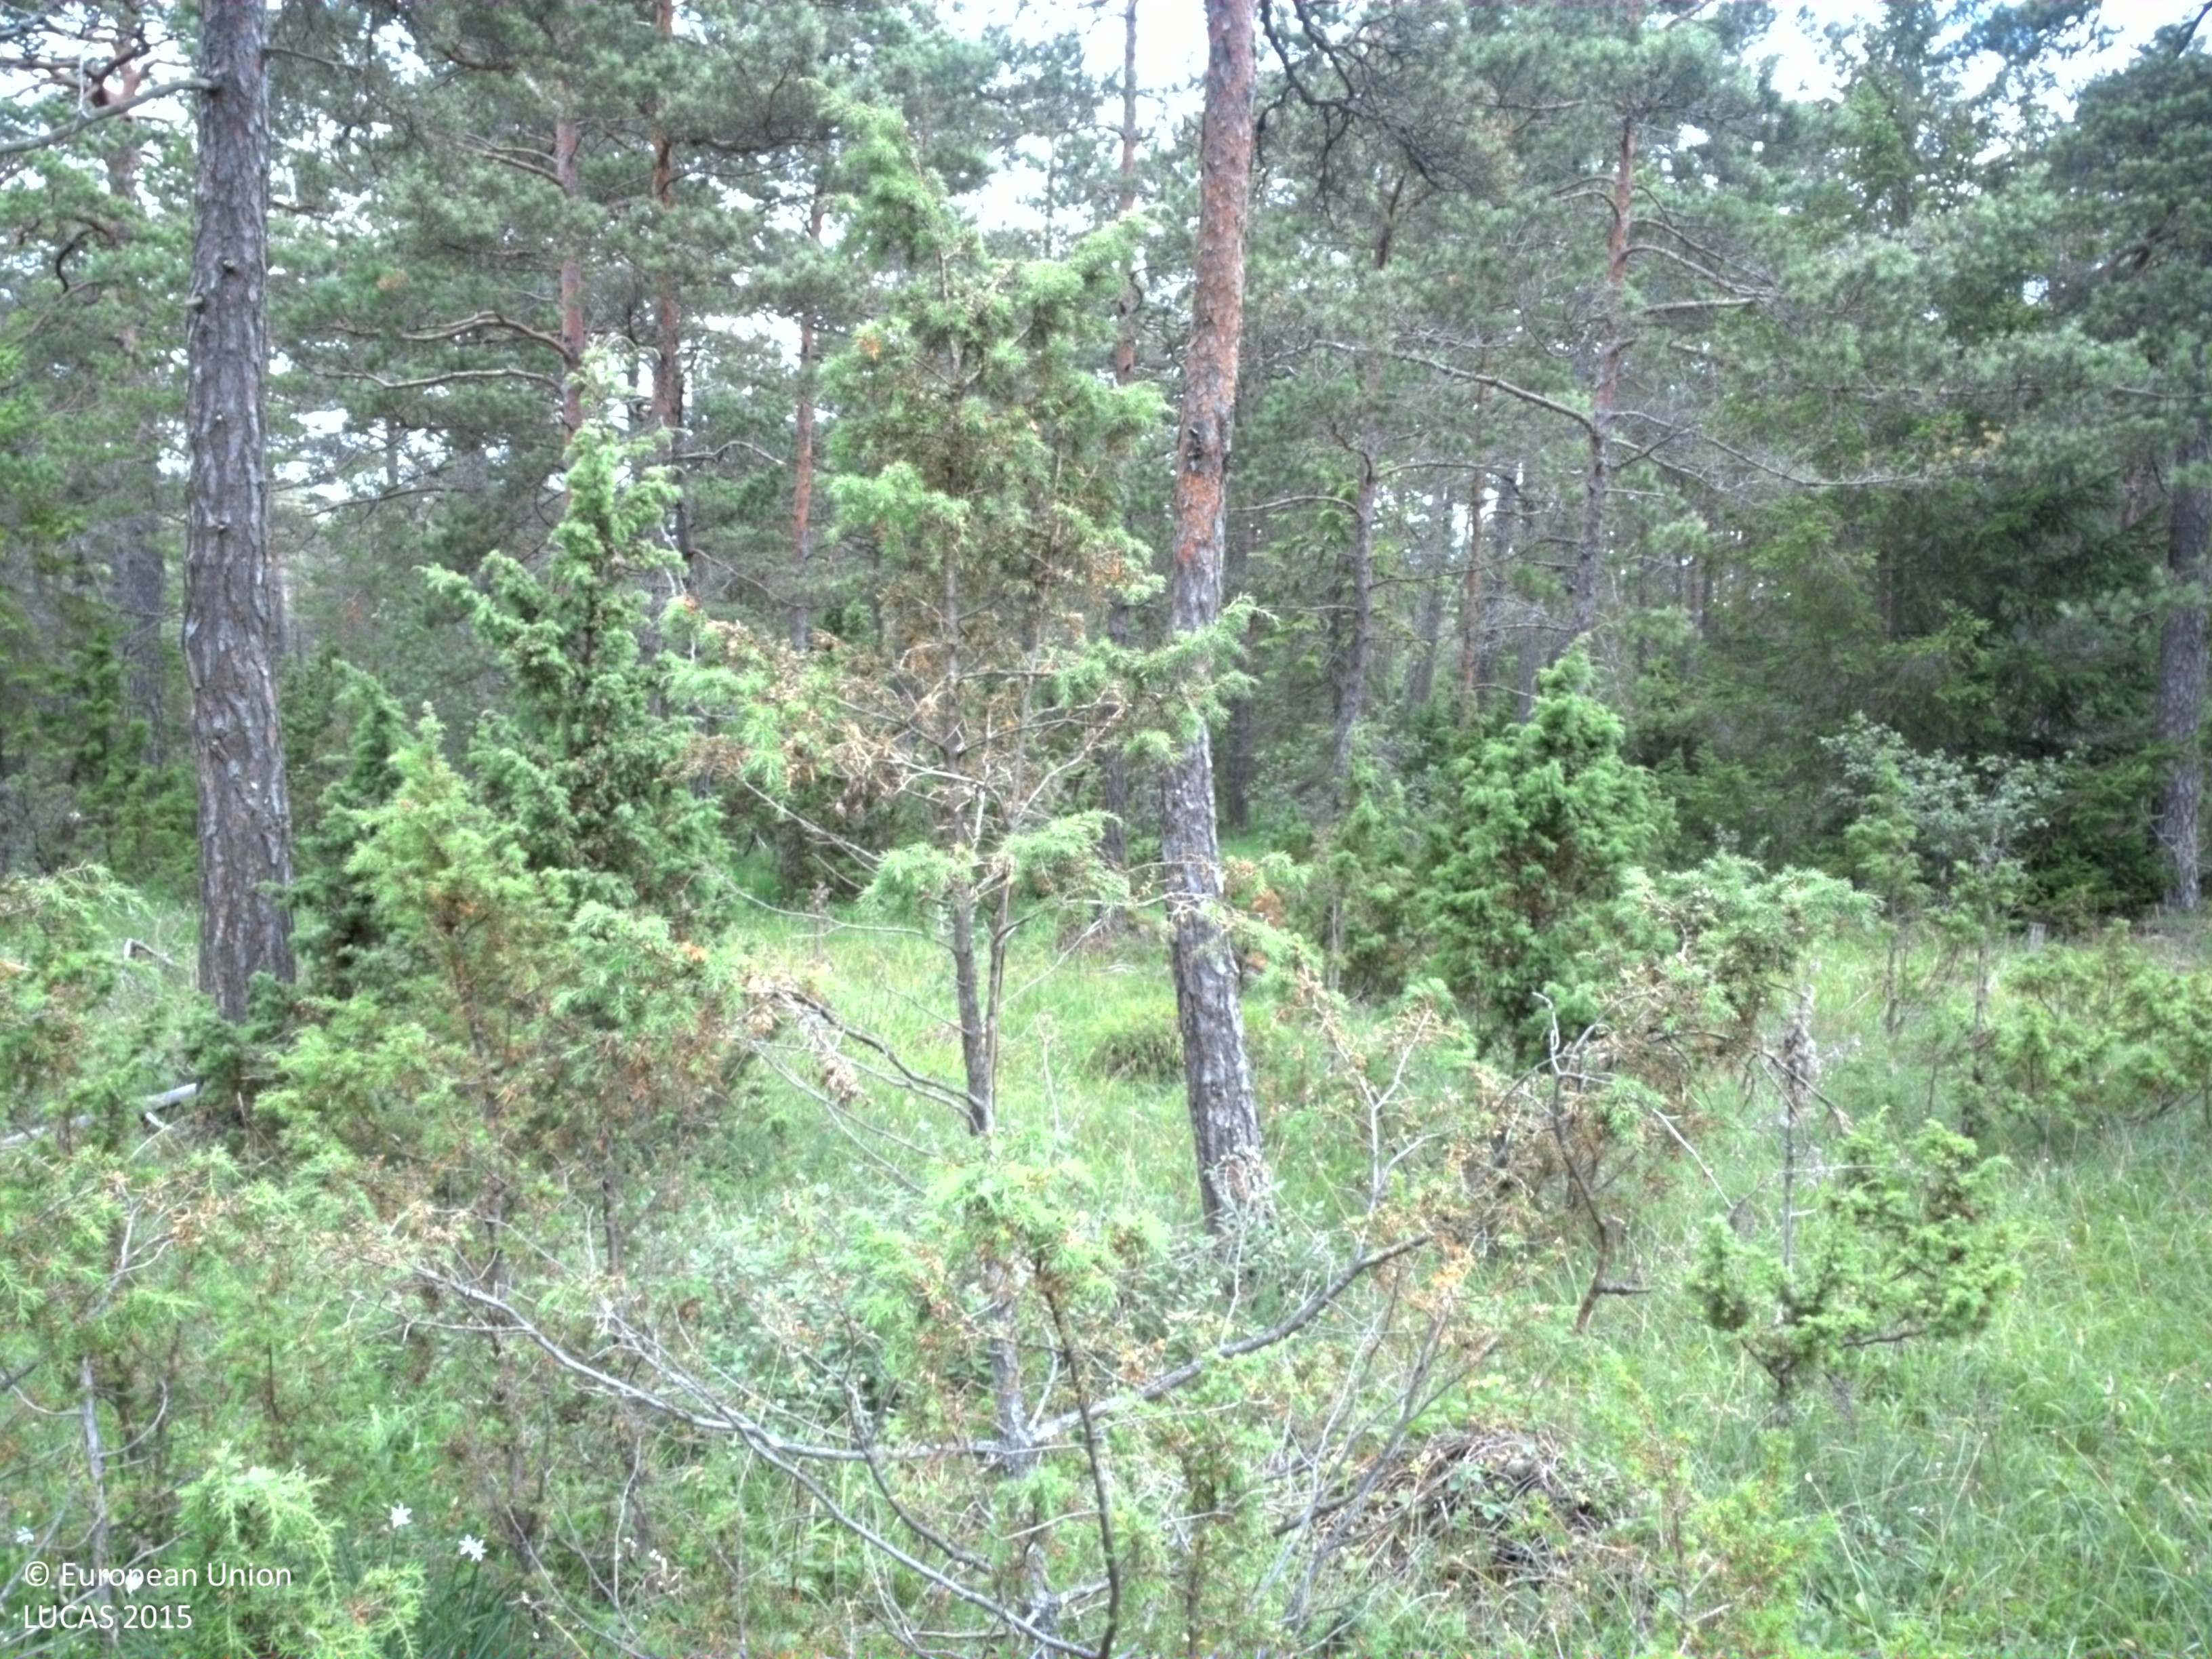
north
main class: Shrubland
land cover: Shrubland with sparse tree cover
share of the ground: 50 - 75 %
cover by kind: shrubs 55 %, herbaceous plants 40 %, coniferous forest trees 5 %
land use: Forestry
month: July
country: SE
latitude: 57.5423
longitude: 18.6468
